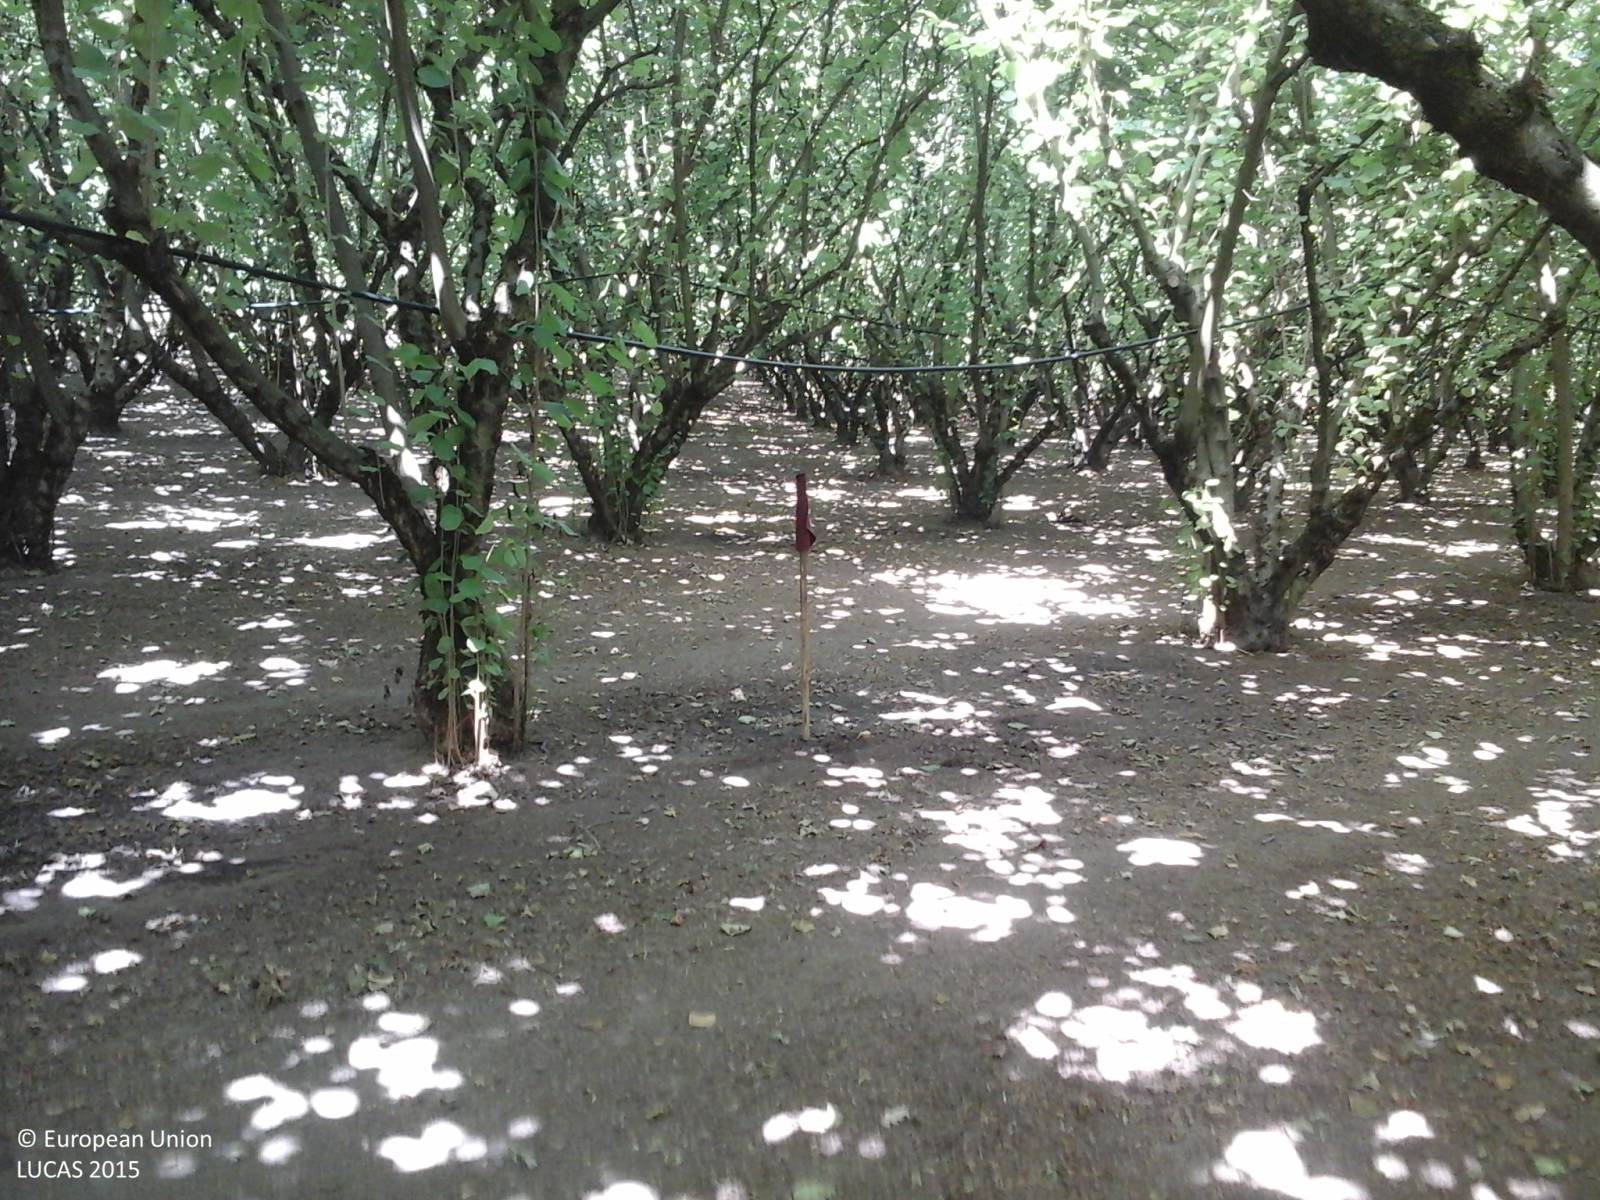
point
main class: Cropland
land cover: Nuts trees
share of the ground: > 75 %
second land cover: Other bare soil
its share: > 75 %
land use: Agriculture (excluding fallow land and kitchen gardens)
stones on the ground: < 10 %
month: July
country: IT
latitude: 42.2844
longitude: 12.3082
